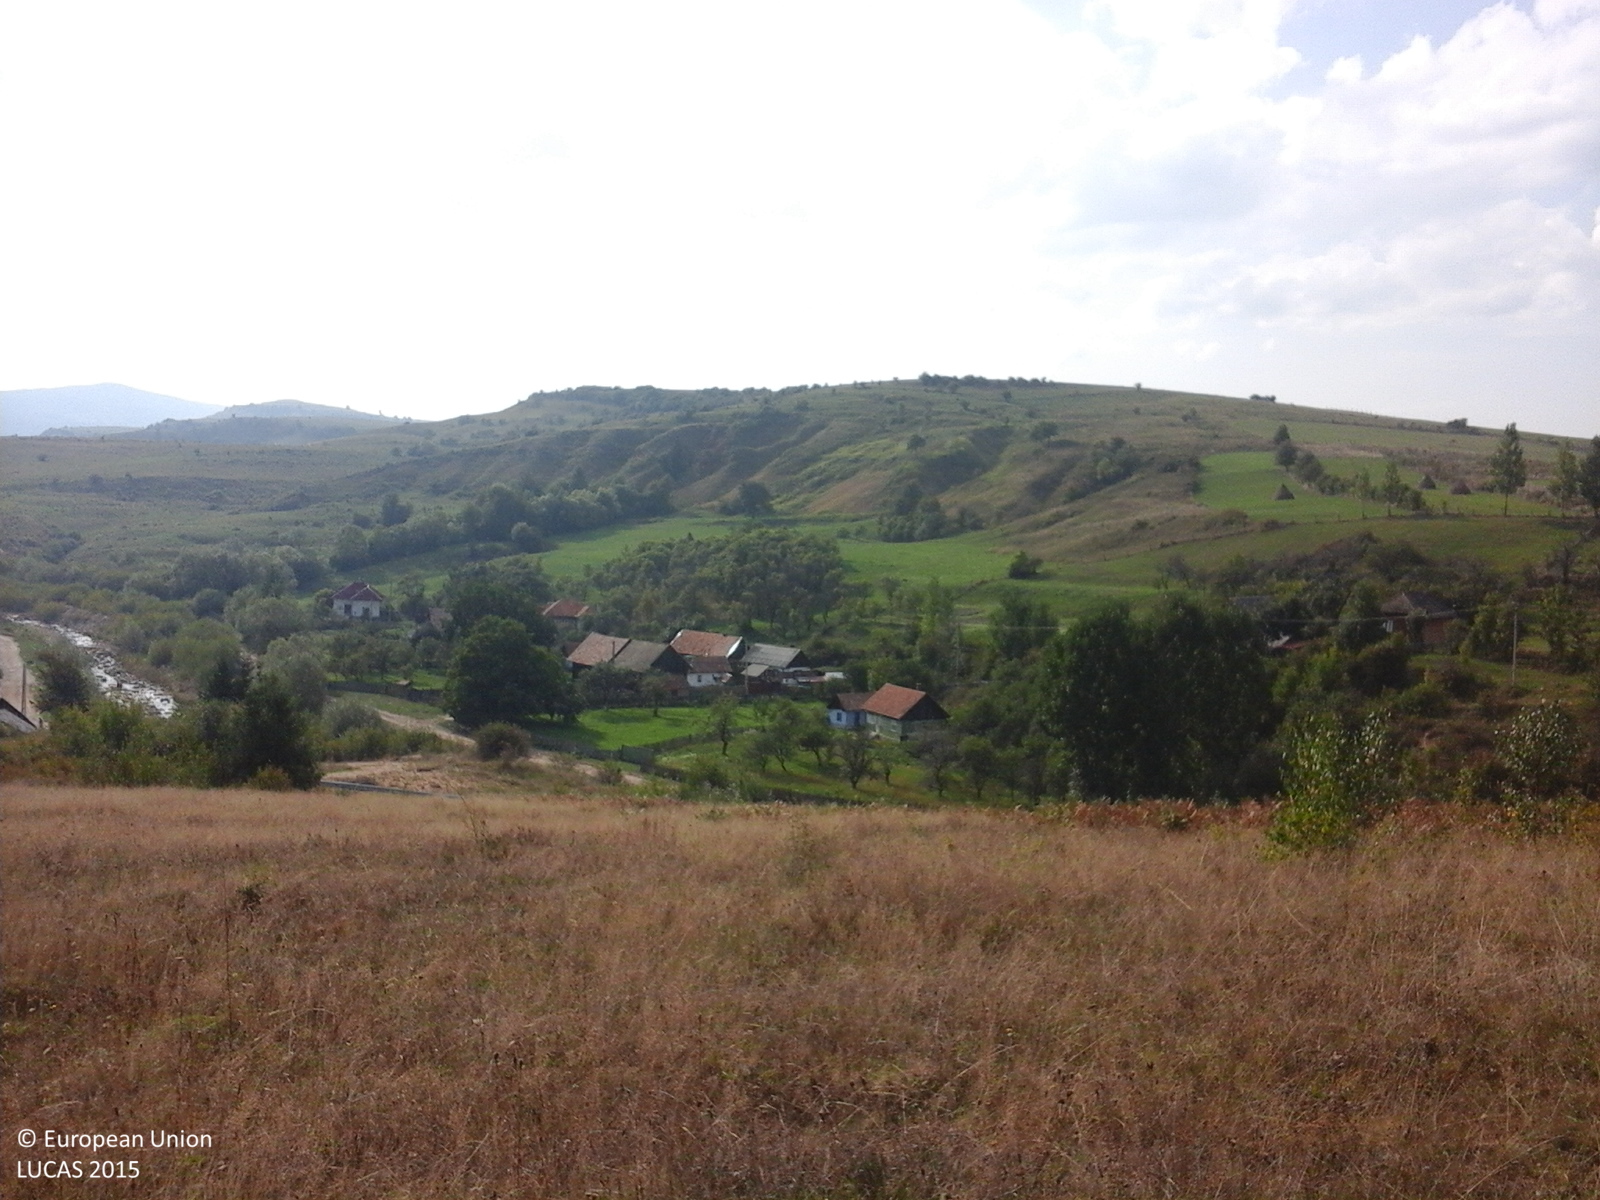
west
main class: Grassland
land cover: Grassland without tree/shrub cover
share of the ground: > 75 %
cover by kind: herbaceous plants 100 %
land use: Agriculture (excluding fallow land and kitchen gardens)
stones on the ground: < 10 %
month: September
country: RO
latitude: 46.7561
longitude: 23.0087
